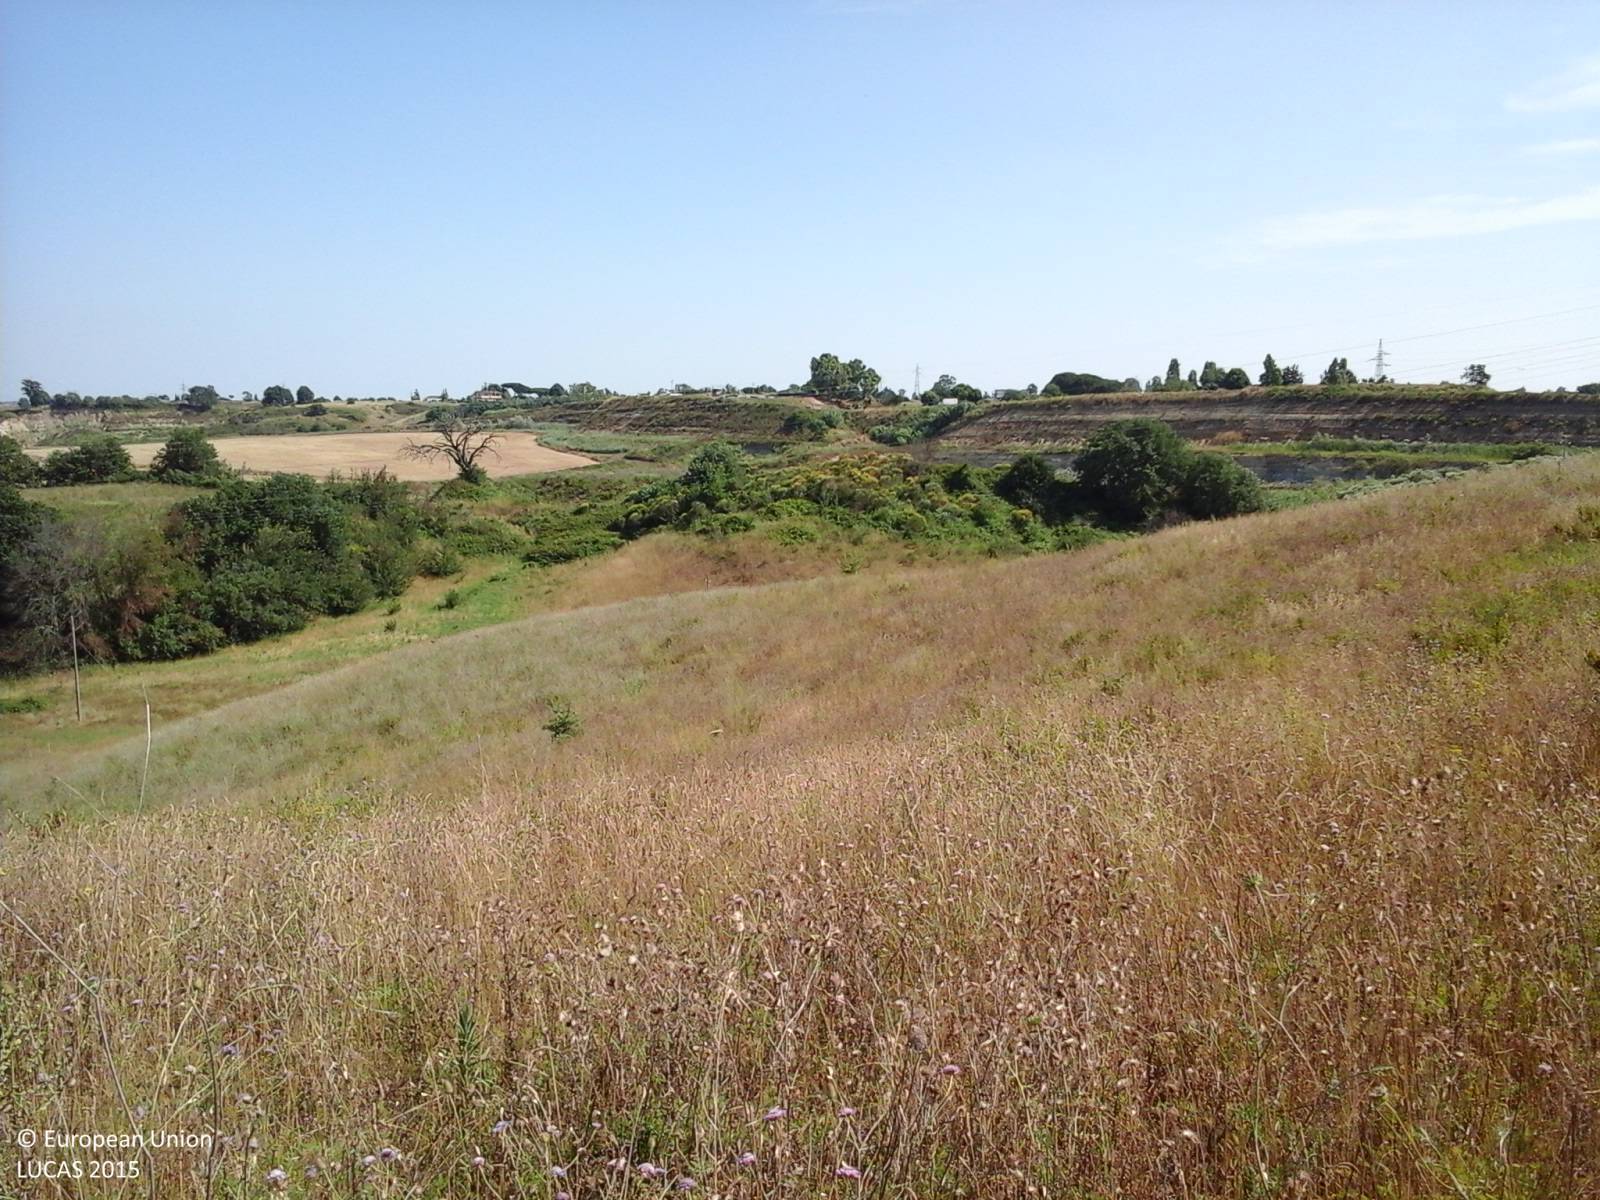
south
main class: Grassland
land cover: Grassland without tree/shrub cover
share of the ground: > 75 %
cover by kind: herbaceous plants 100 %
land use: Semi-natural and natural areas not in use
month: June
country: IT
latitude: 41.8504
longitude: 12.3158
